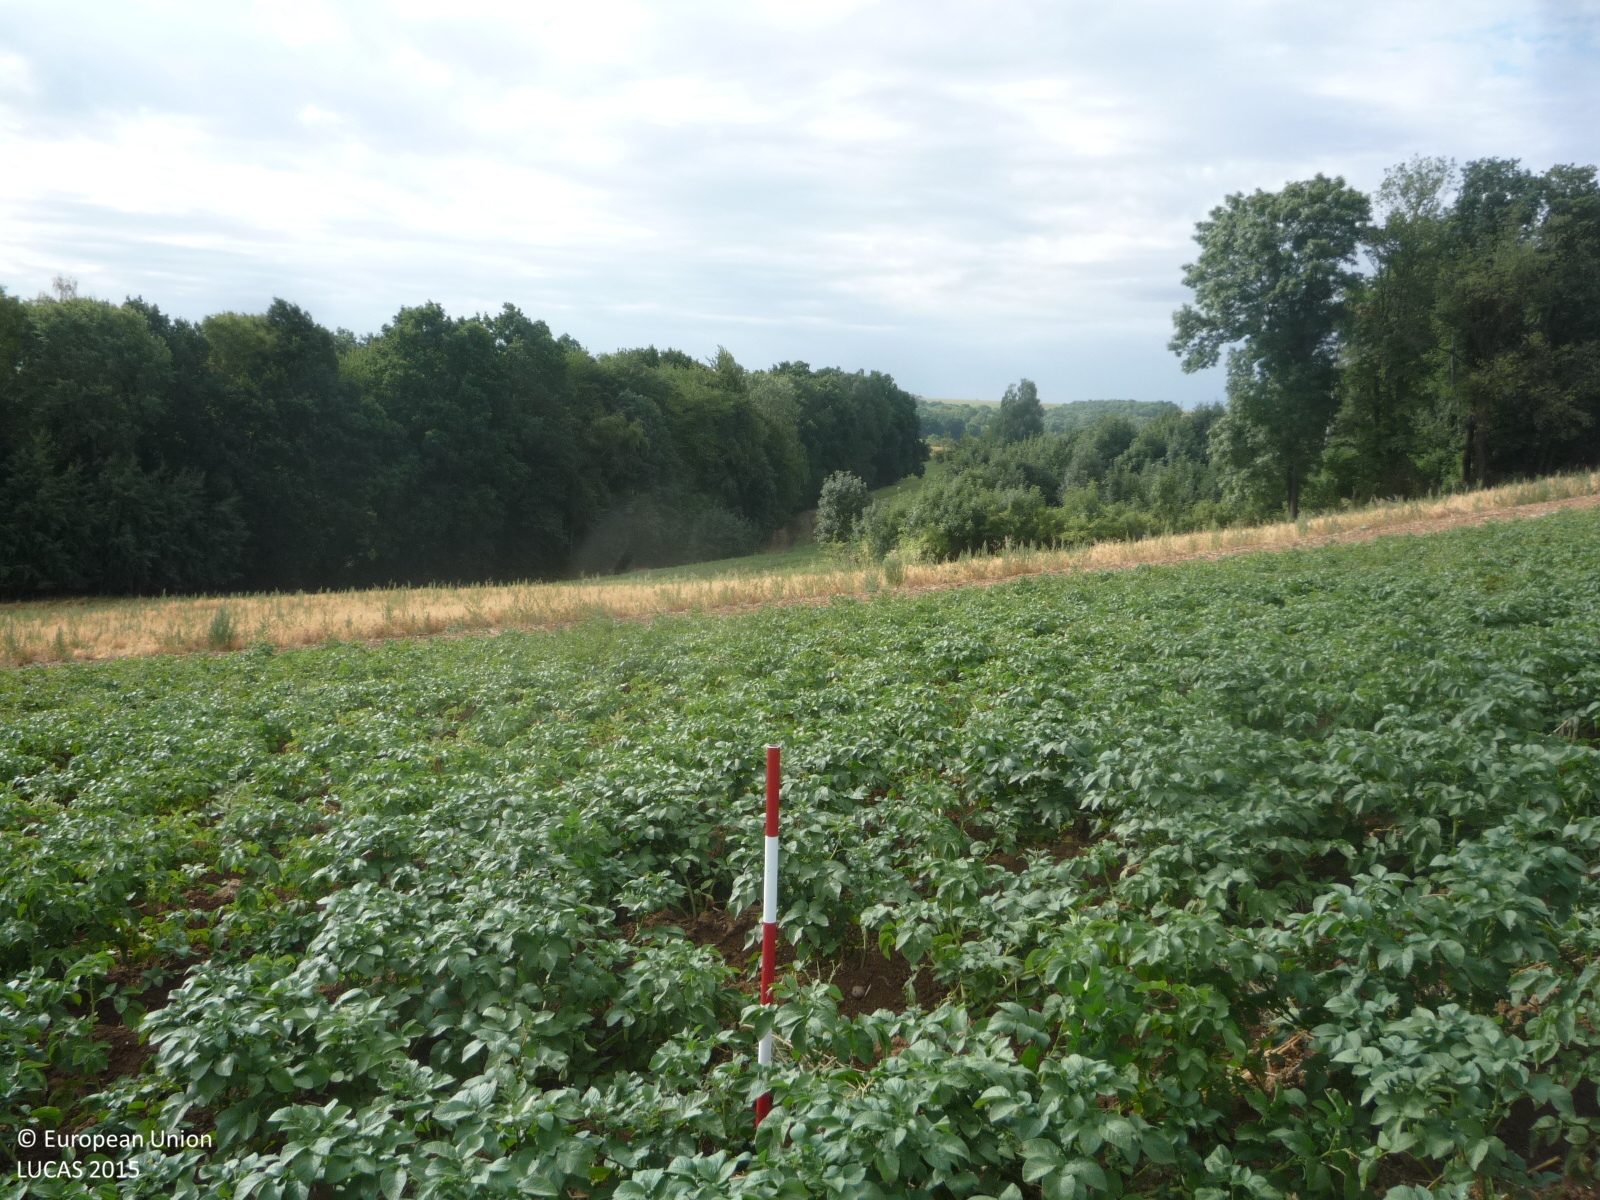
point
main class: Cropland
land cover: Potatoes
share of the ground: > 75 %
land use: Agriculture (excluding fallow land and kitchen gardens)
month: July
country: CZ
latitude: 50.4069
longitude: 15.2236
